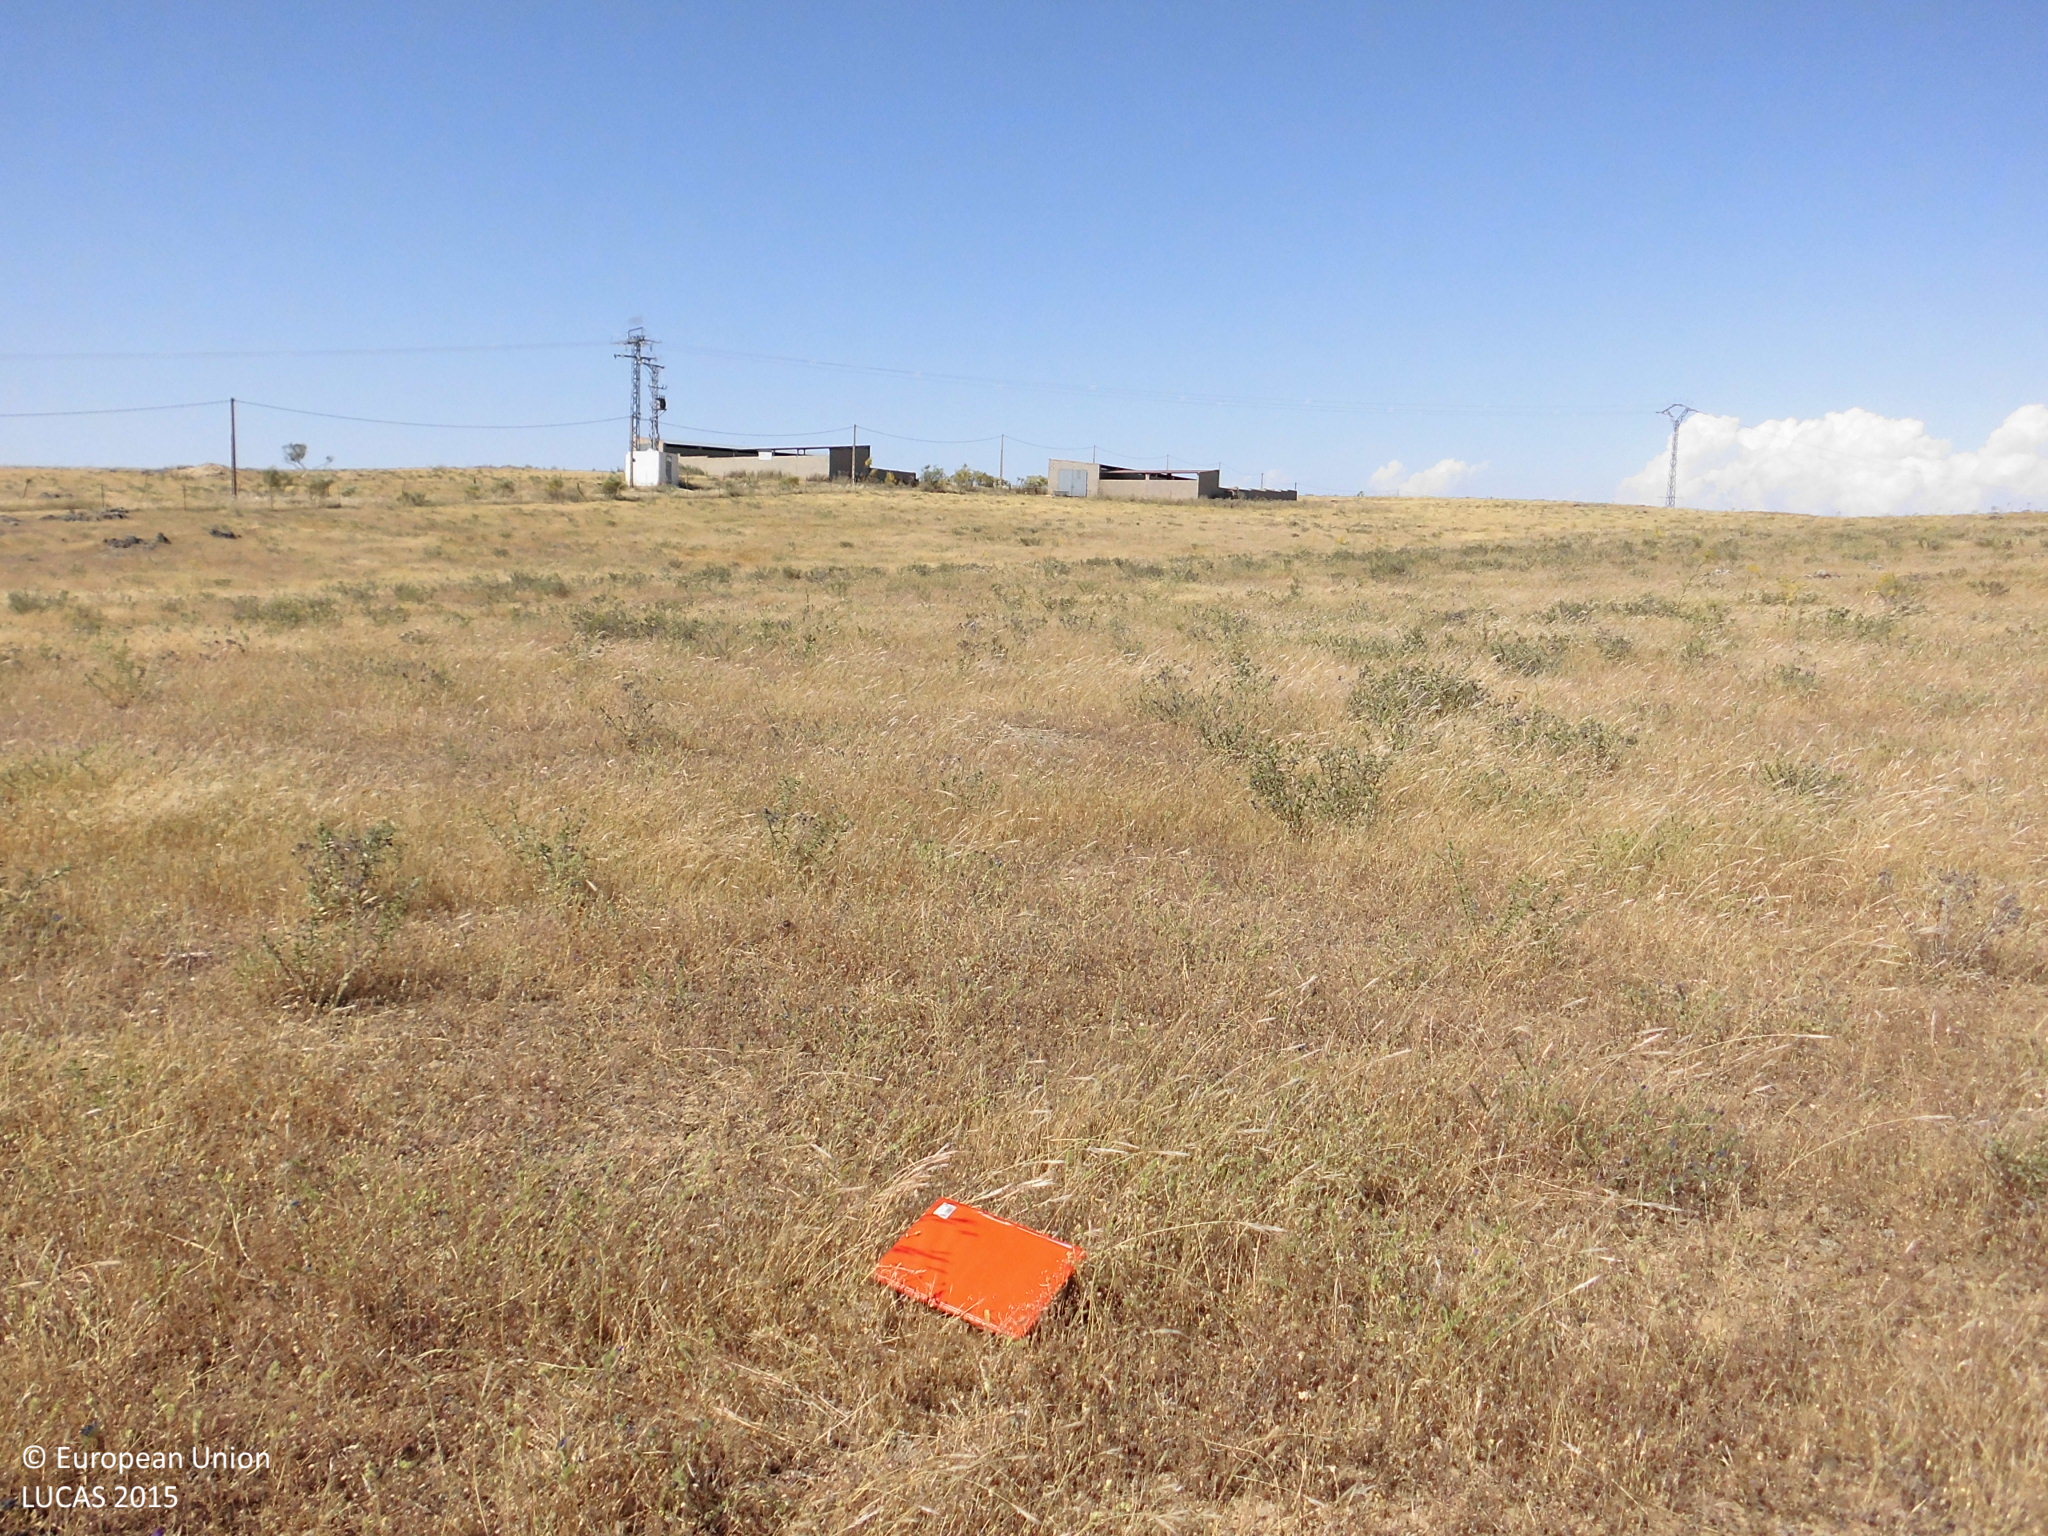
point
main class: Grassland
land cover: Grassland without tree/shrub cover
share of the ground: > 75 %
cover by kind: herbaceous plants 100 %
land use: Agriculture (excluding fallow land and kitchen gardens)
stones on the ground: 10 - 25 %
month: May
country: ES
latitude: 39.3750
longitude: -6.0680
